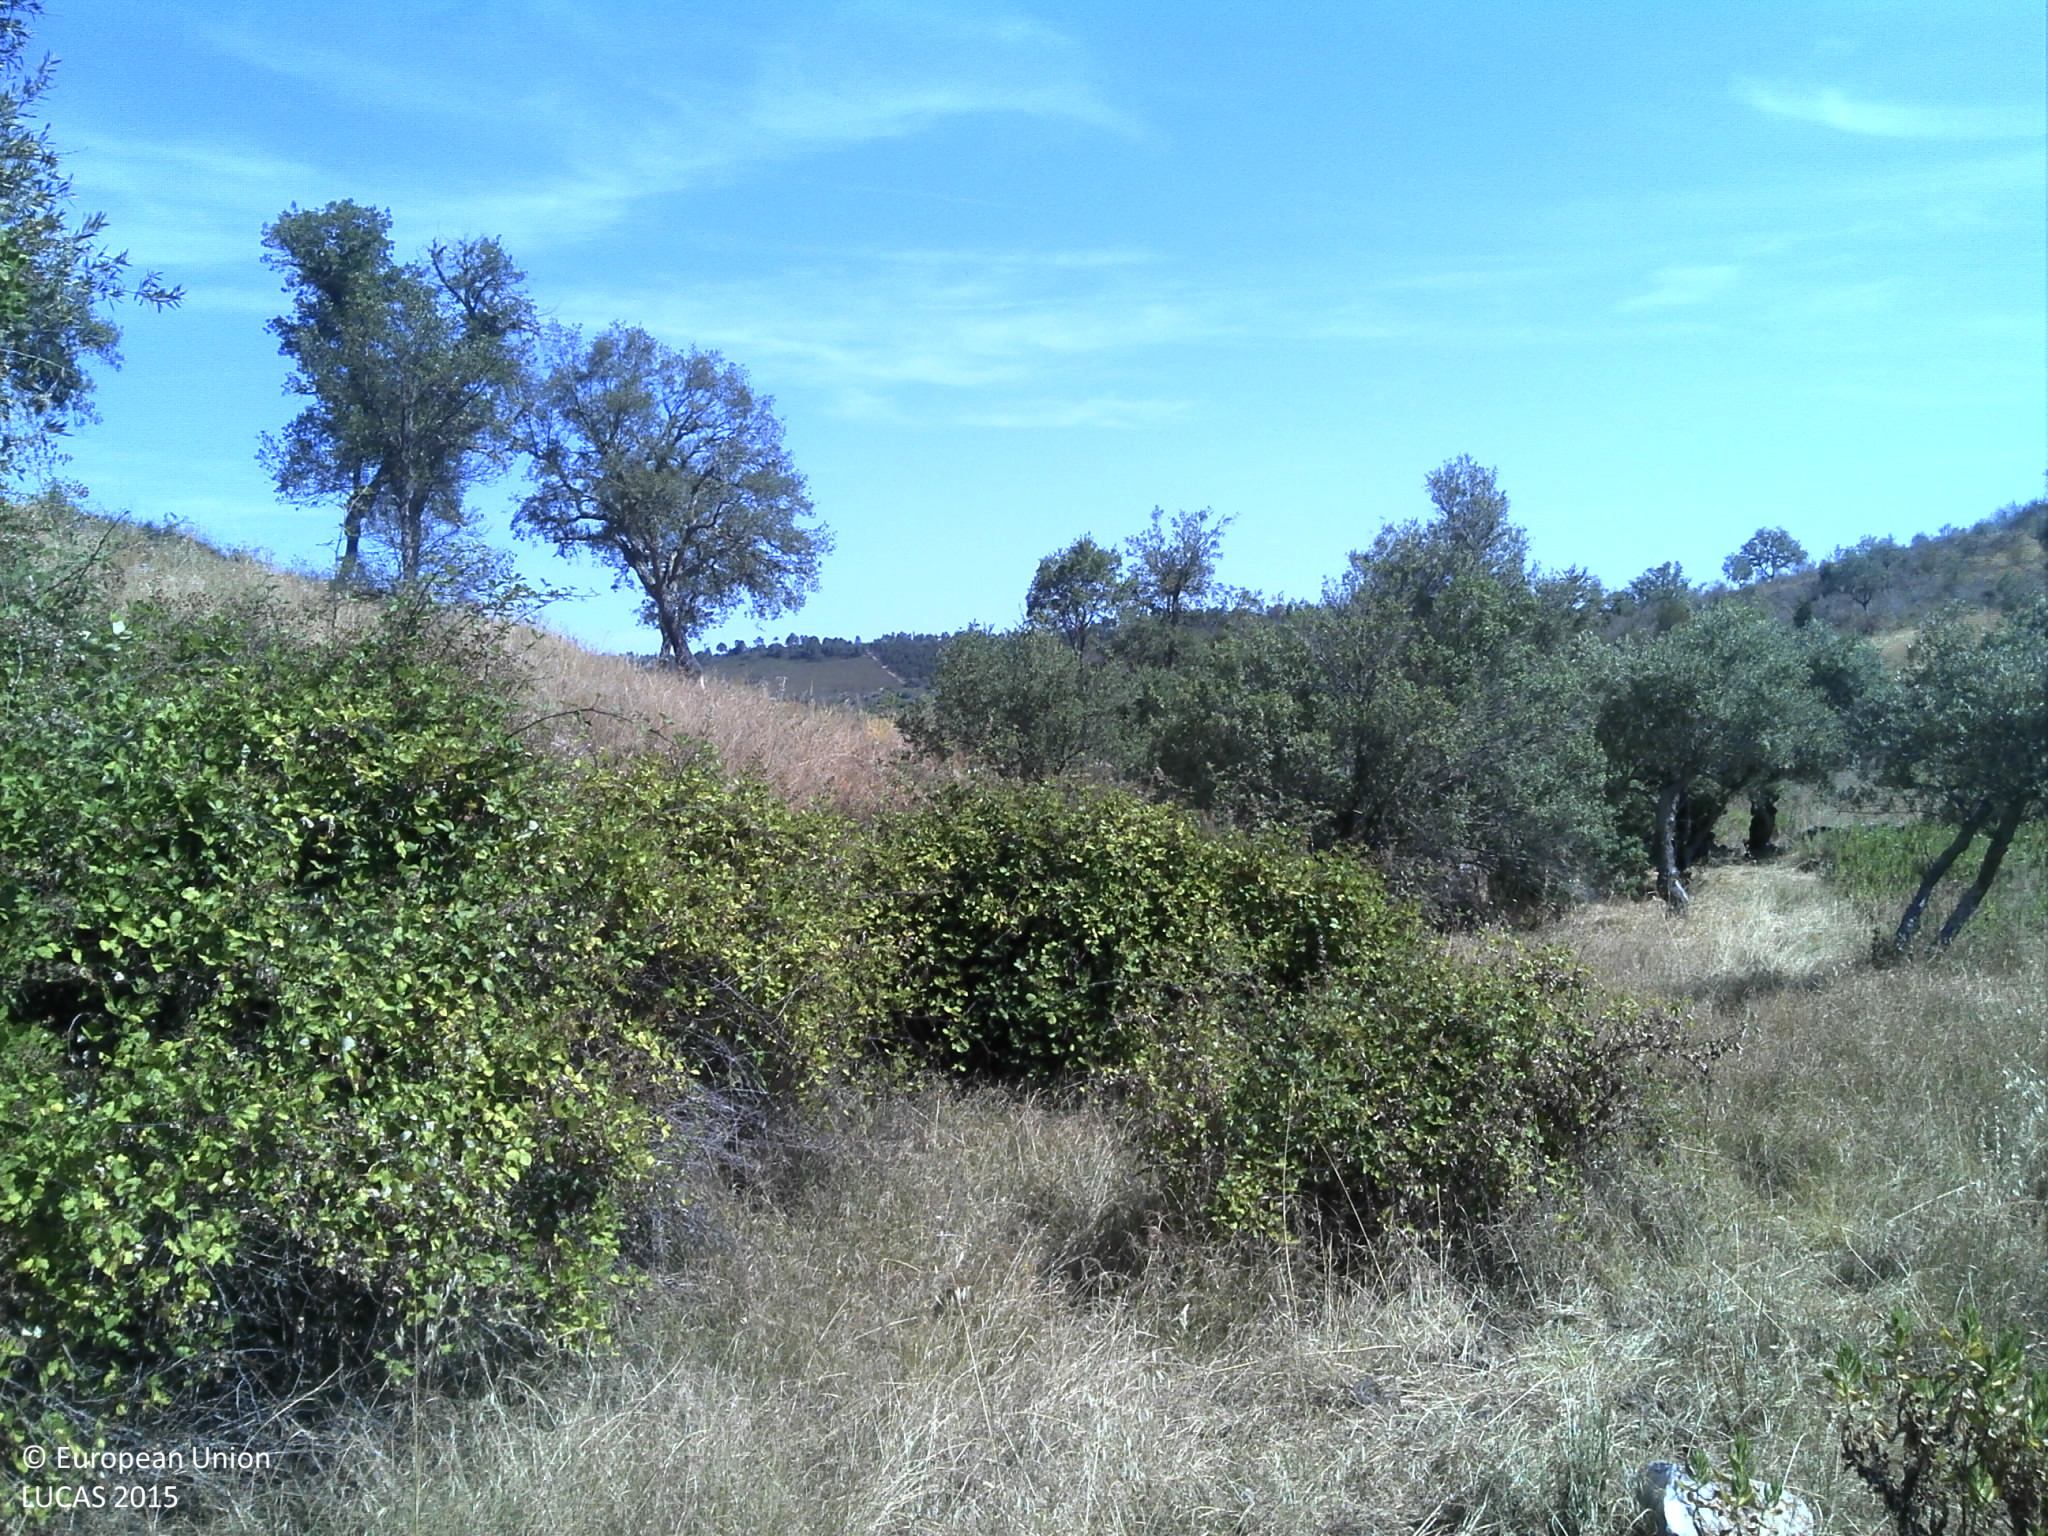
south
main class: Woodland
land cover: Broadleaved woodland
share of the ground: 25 - 50 %
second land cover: Spontaneously vegetated surfaces
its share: 25 - 50 %
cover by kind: herbaceous plants 40 %, broadleaved forest trees 35 %, unconsolidated bare surface 20 %, shrubs 5 %
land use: Forestry
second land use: Agriculture (excluding fallow land and kitchen gardens)
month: July
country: PT
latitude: 39.6645
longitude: -7.5711
